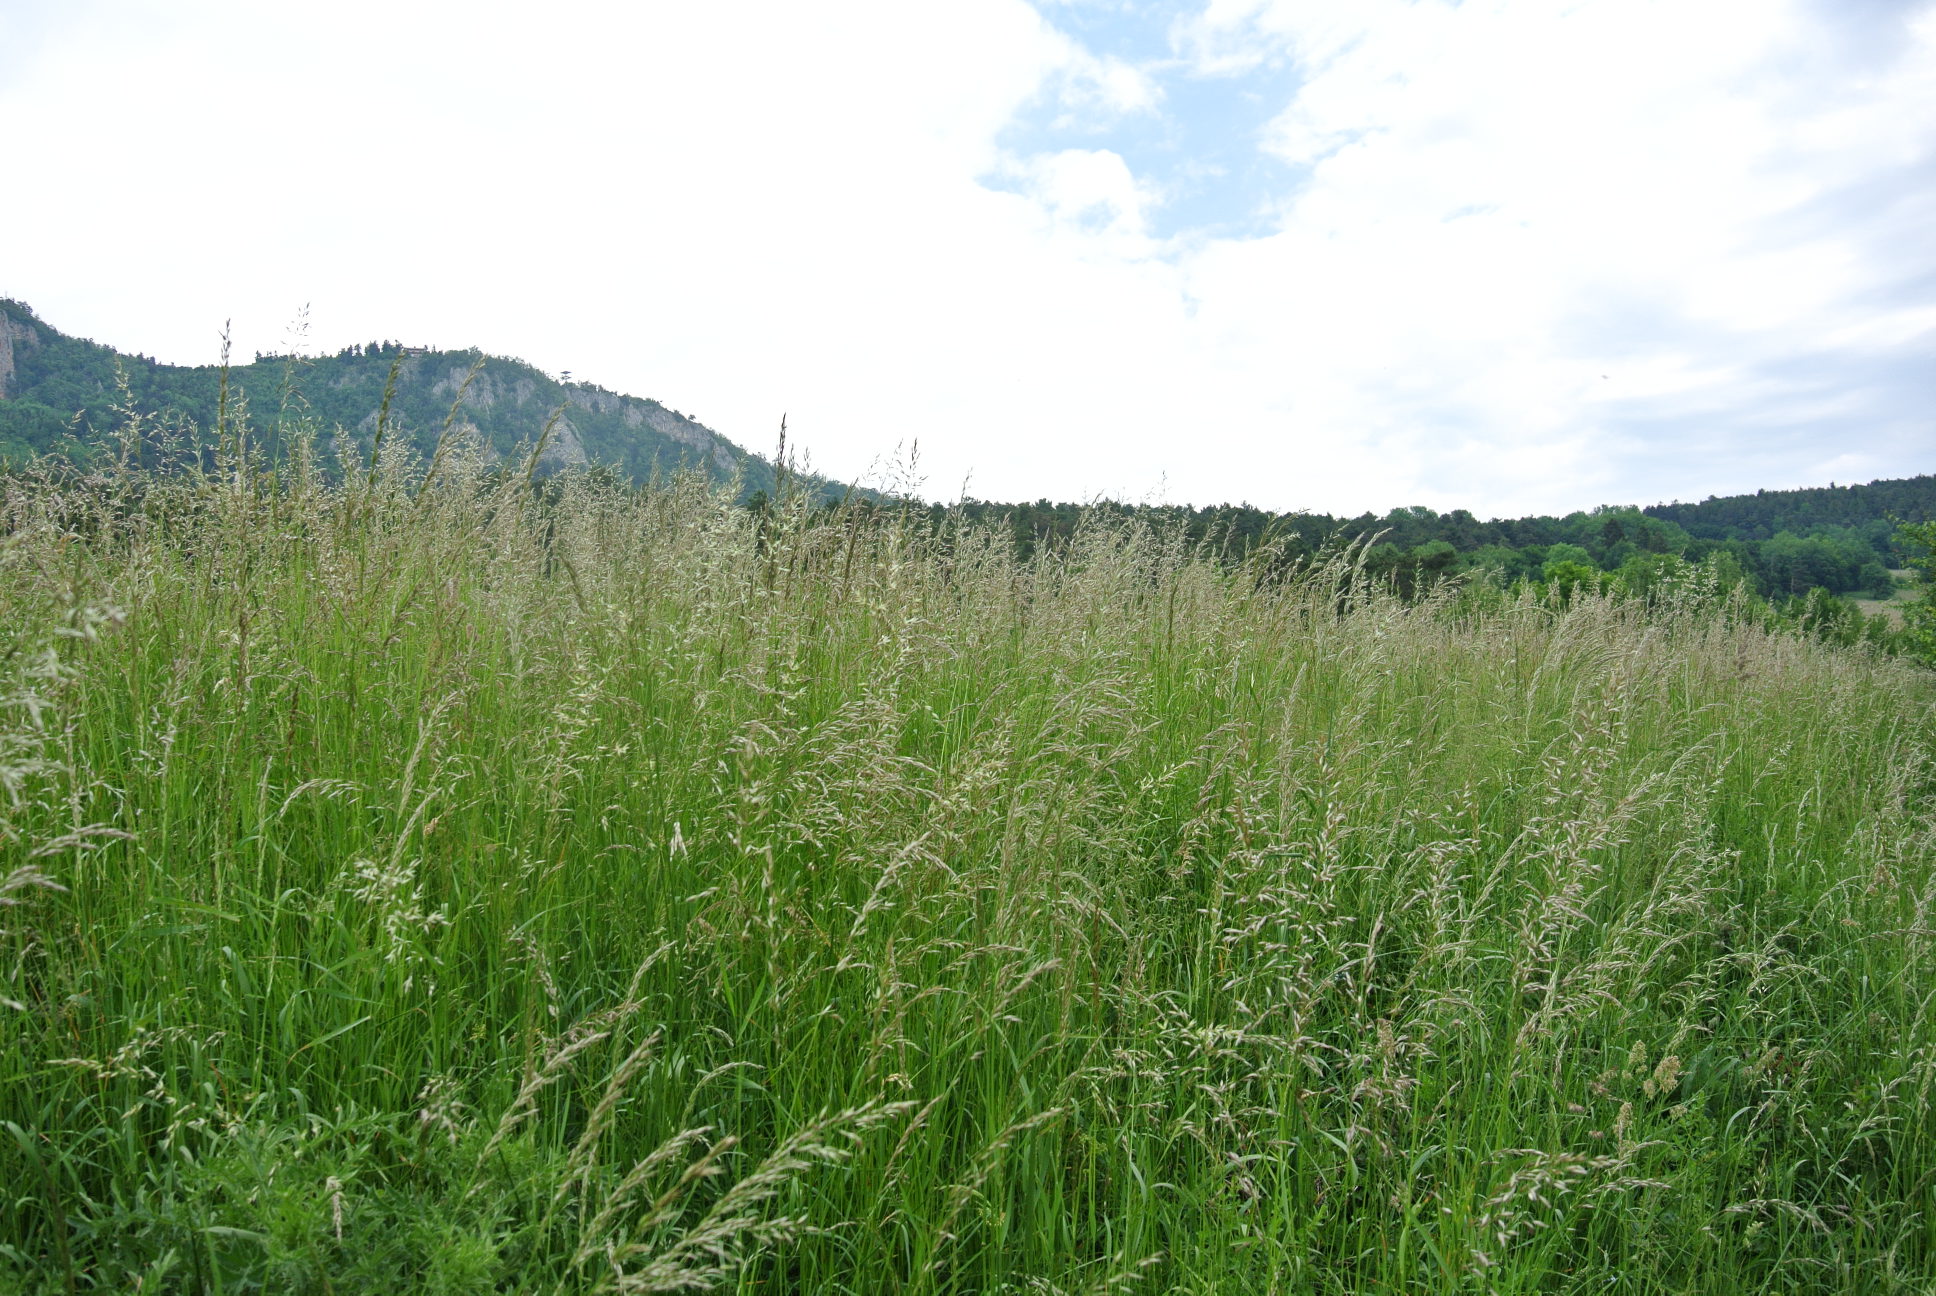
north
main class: Grassland
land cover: Grassland without tree/shrub cover
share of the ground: > 75 %
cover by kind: herbaceous plants 100 %
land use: Agriculture (excluding fallow land and kitchen gardens)
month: May
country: AT
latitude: 47.8390
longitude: 16.0826
